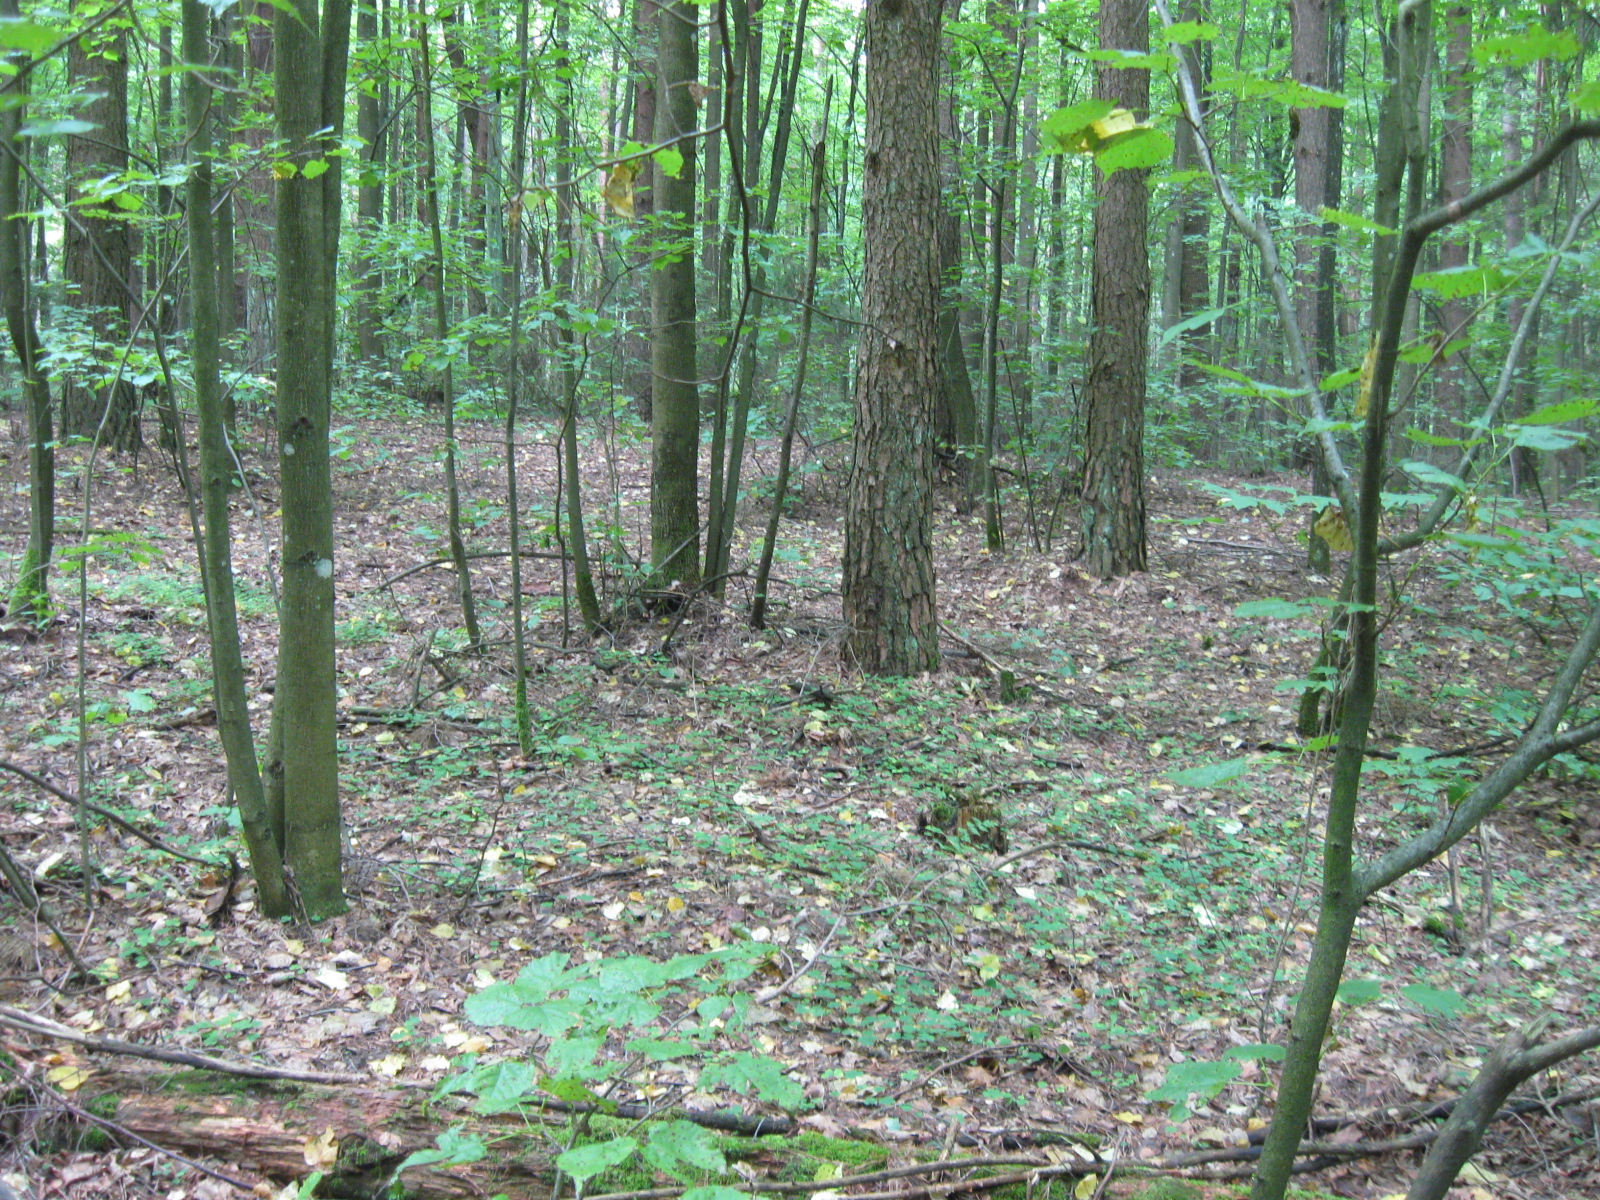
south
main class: Woodland
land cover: Pine dominated mixed woodland
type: hemiboreal forest and nemoral coniferous forest and mixed broadleaved-coniferous forest
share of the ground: > 75 %
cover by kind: broadleaved forest trees 45 %, coniferous forest trees 40 %, unconsolidated bare surface 10 %, herbaceous plants 5 %
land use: Forestry
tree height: > 5 m
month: July
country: LT
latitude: 55.0196
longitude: 23.6119
